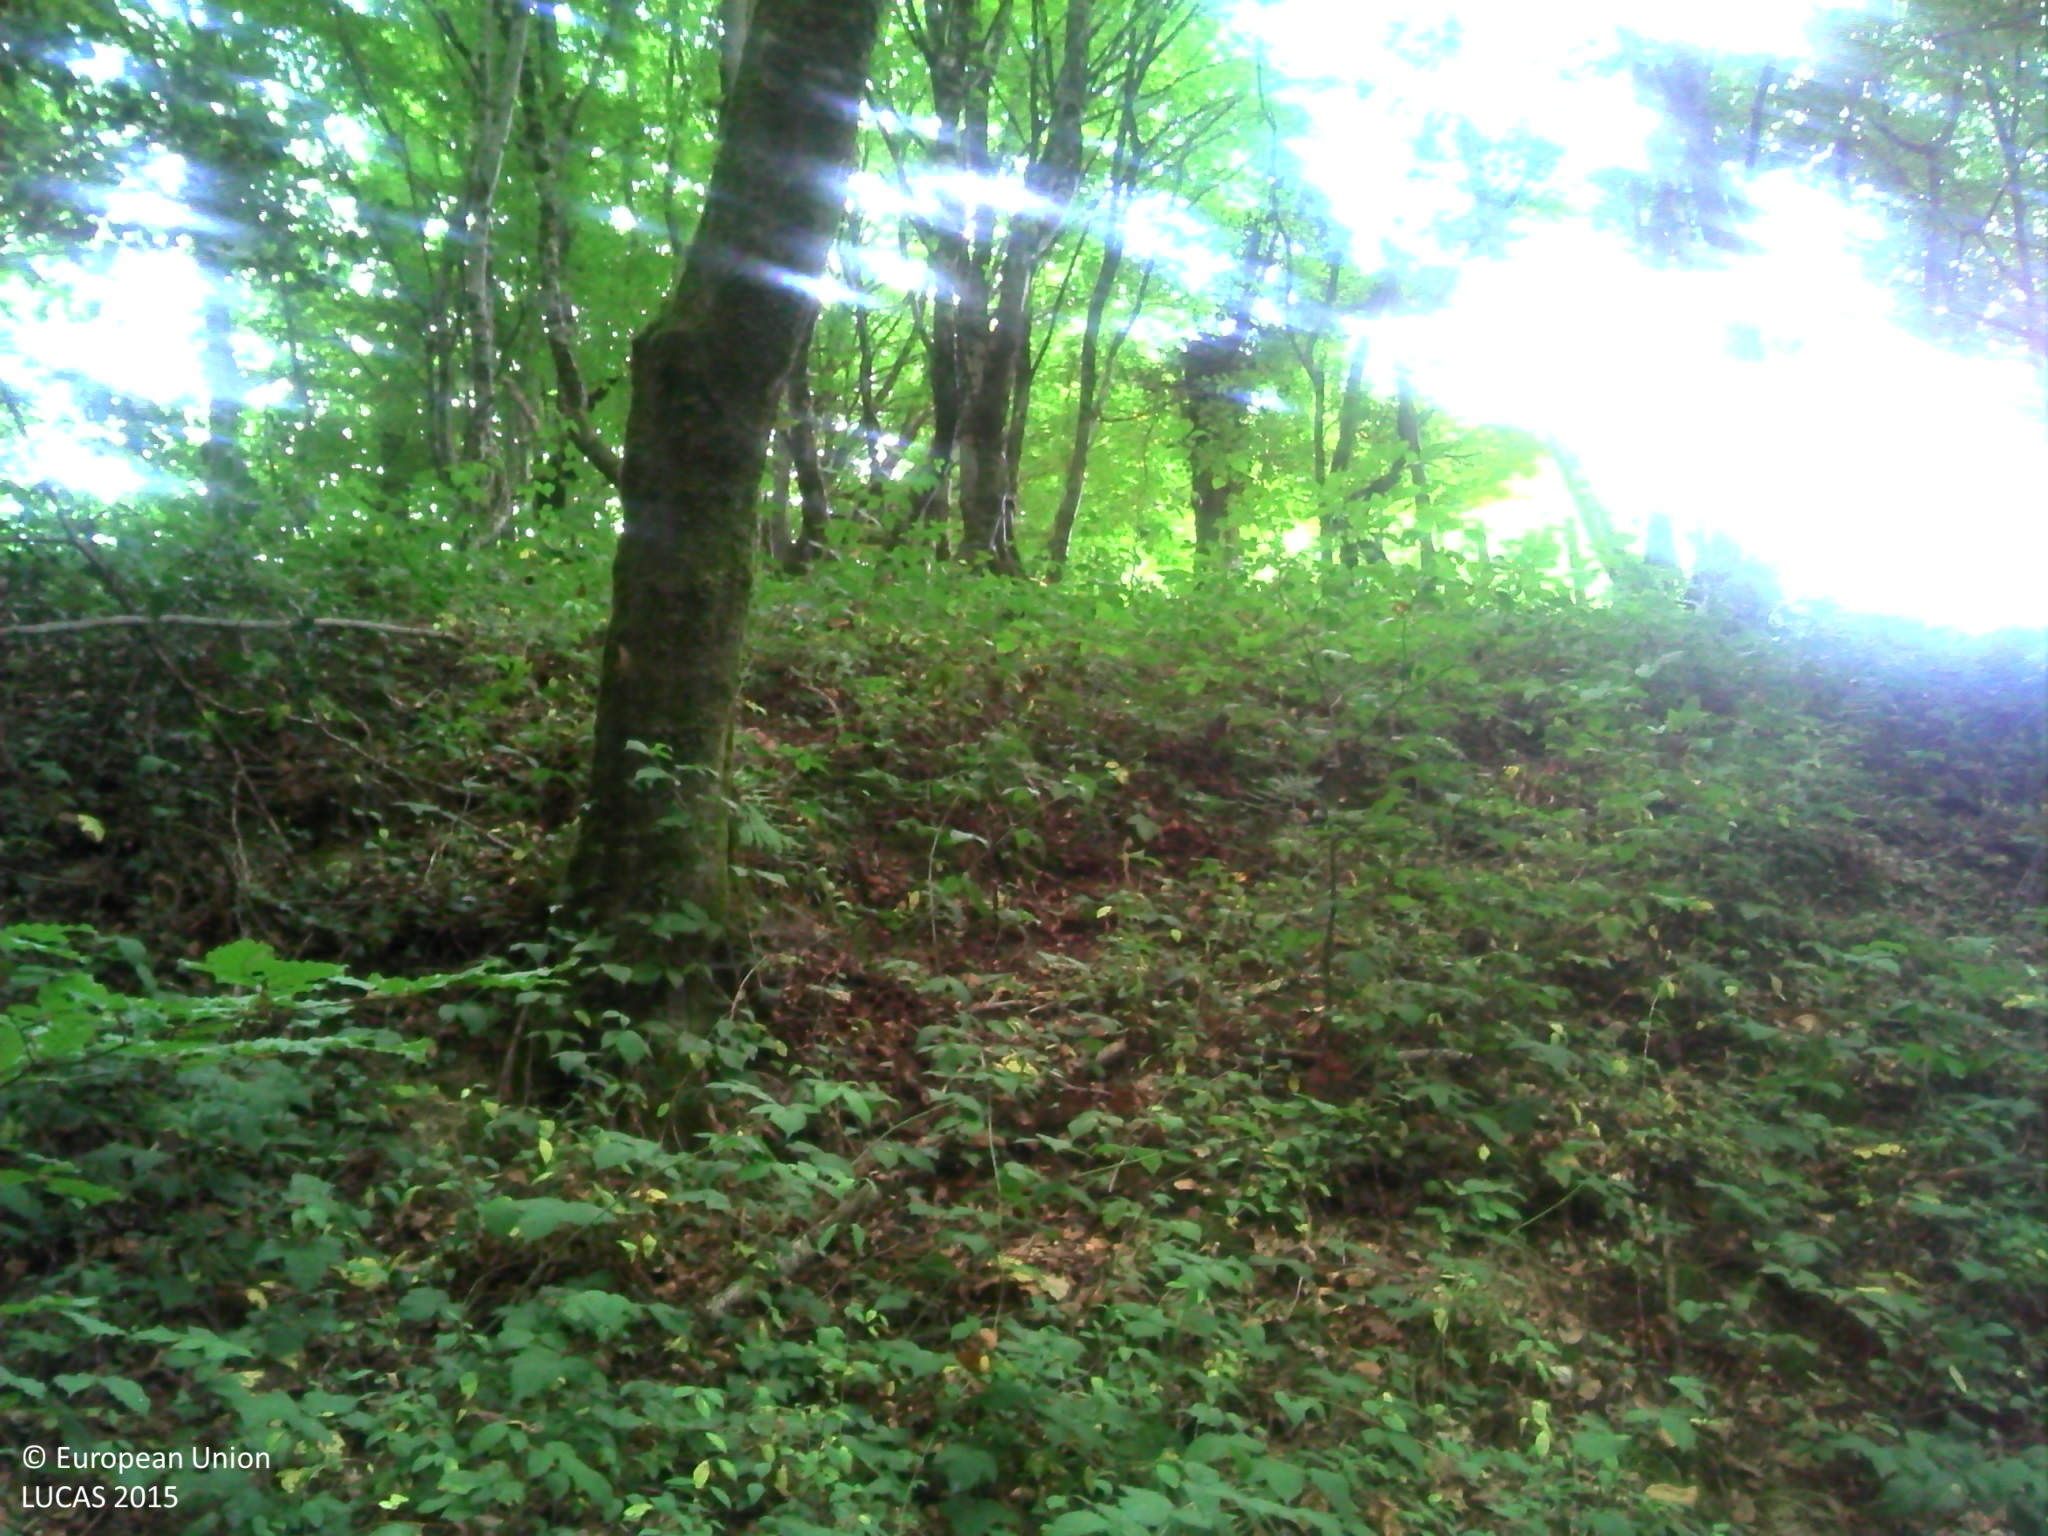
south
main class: Woodland
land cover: Broadleaved woodland
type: mesophytic deciduous forest
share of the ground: > 75 %
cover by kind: broadleaved forest trees 85 %, herbaceous plants 10 %, shrubs 5 %
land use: Forestry
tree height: > 5 m
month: July
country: FR
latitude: 46.3730
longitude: 1.7104
